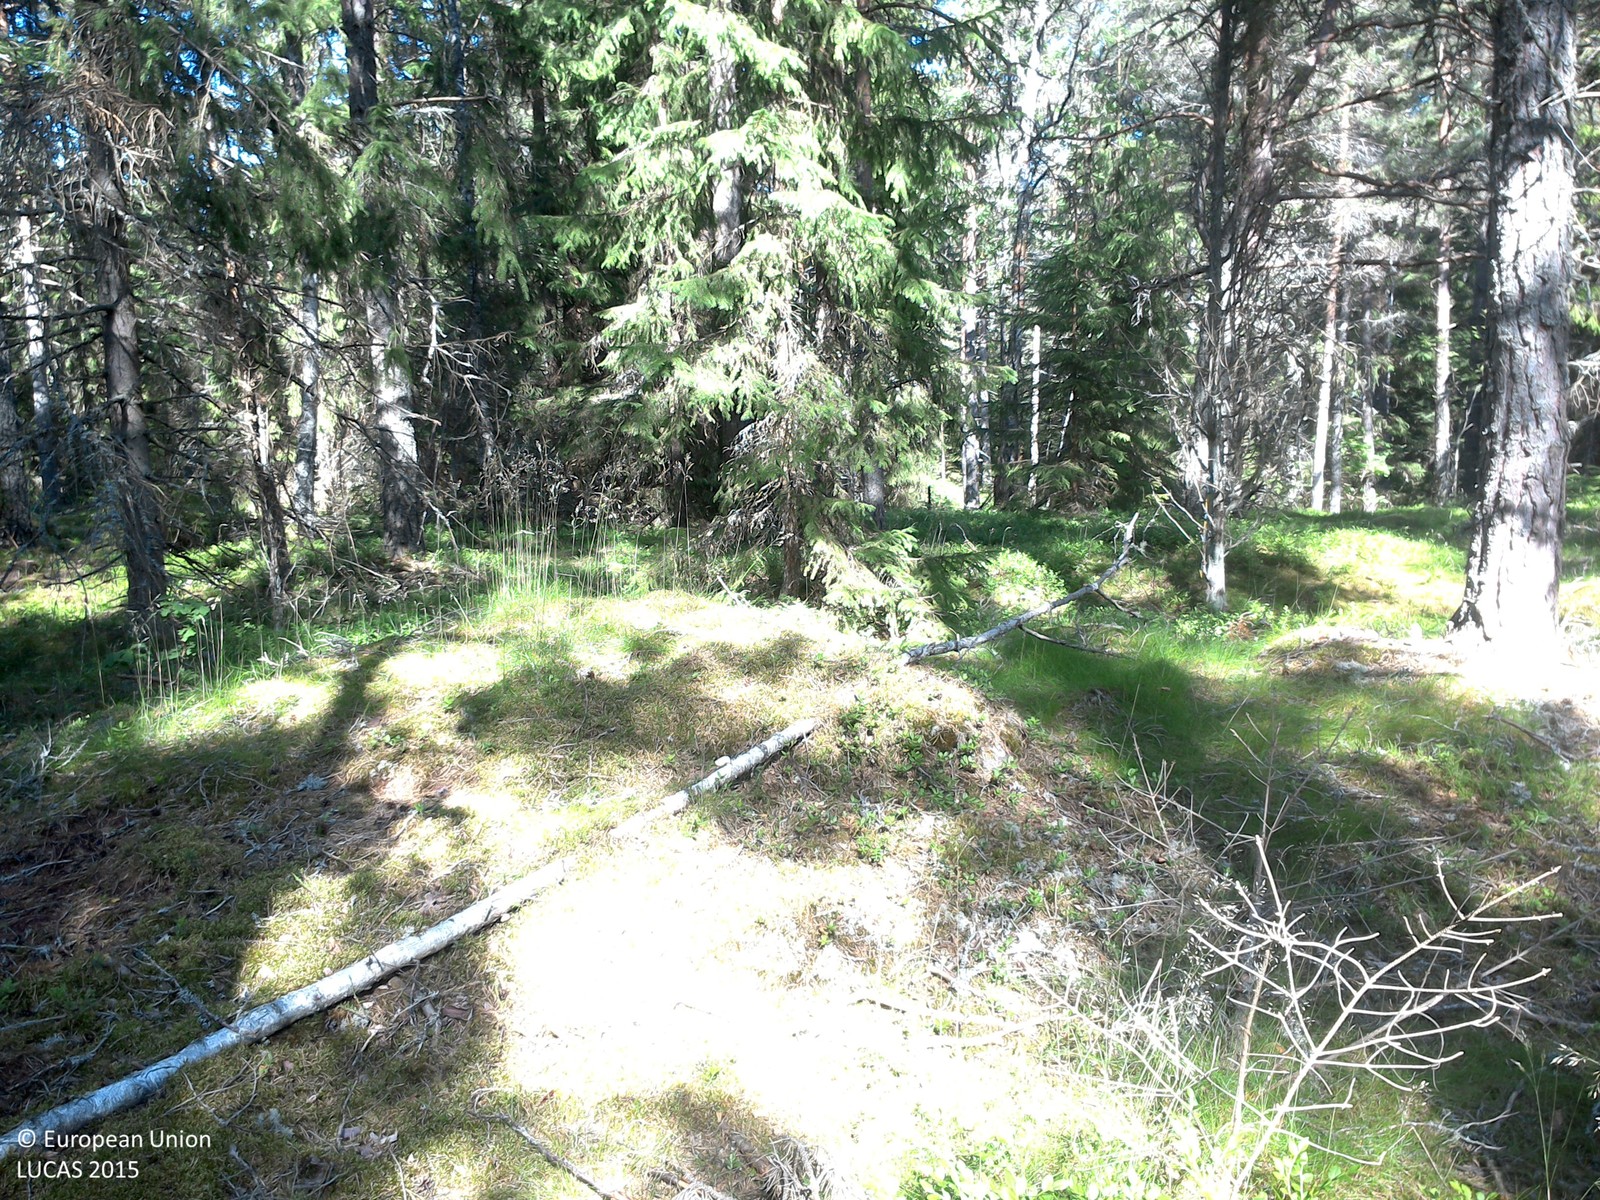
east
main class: Woodland
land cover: Pine dominated coniferous woodland
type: boreal forest
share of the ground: 50 - 75 %
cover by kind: coniferous forest trees 65 %, lichens and mosses 20 %, herbaceous plants 10 %, broadleaved forest trees 5 %
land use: Forestry
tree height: > 5 m
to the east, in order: Pine dominated coniferous woodland; Spruce dominated mixed woodland; Pine dominated mixed woodland
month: June
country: SE
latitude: 58.2499
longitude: 15.5323
